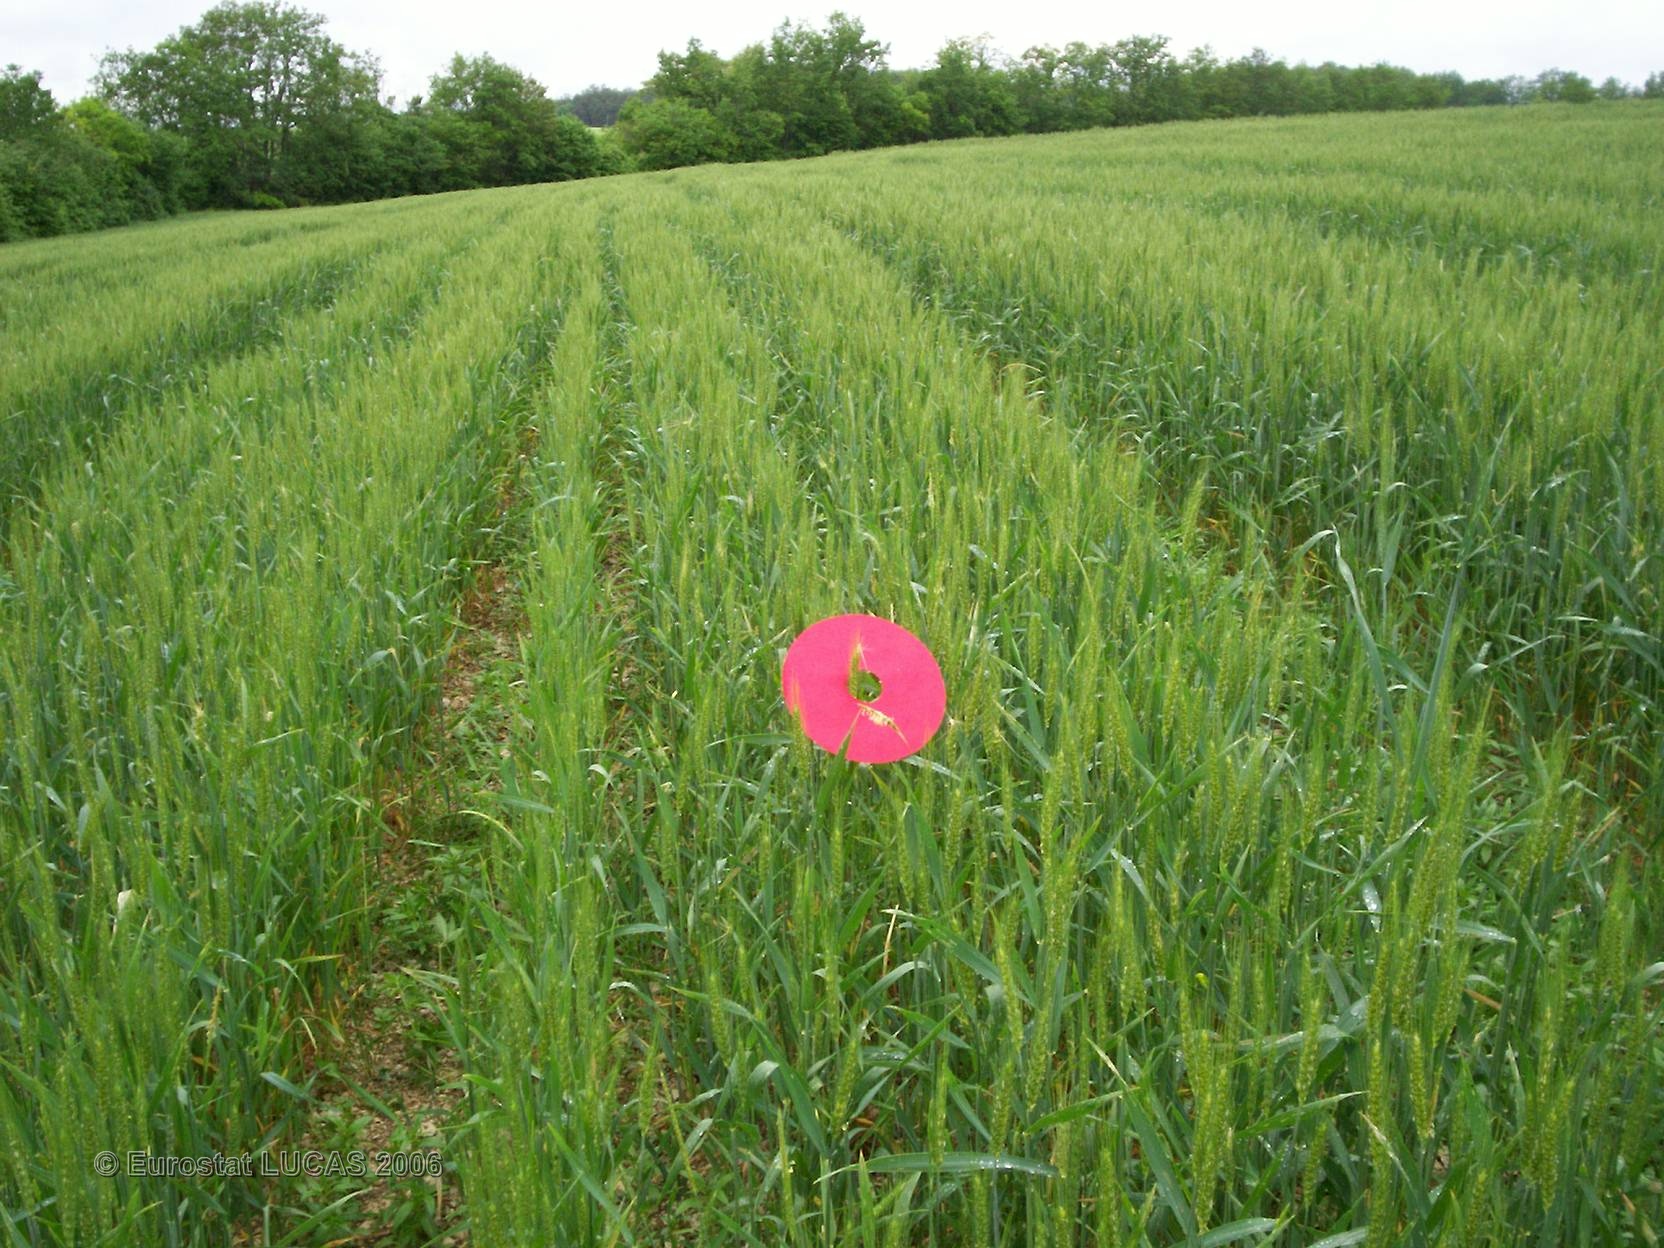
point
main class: Cropland
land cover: Triticale
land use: Agriculture (excluding fallow land and kitchen gardens)
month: May
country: FR
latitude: 45.3879
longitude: 0.5492
